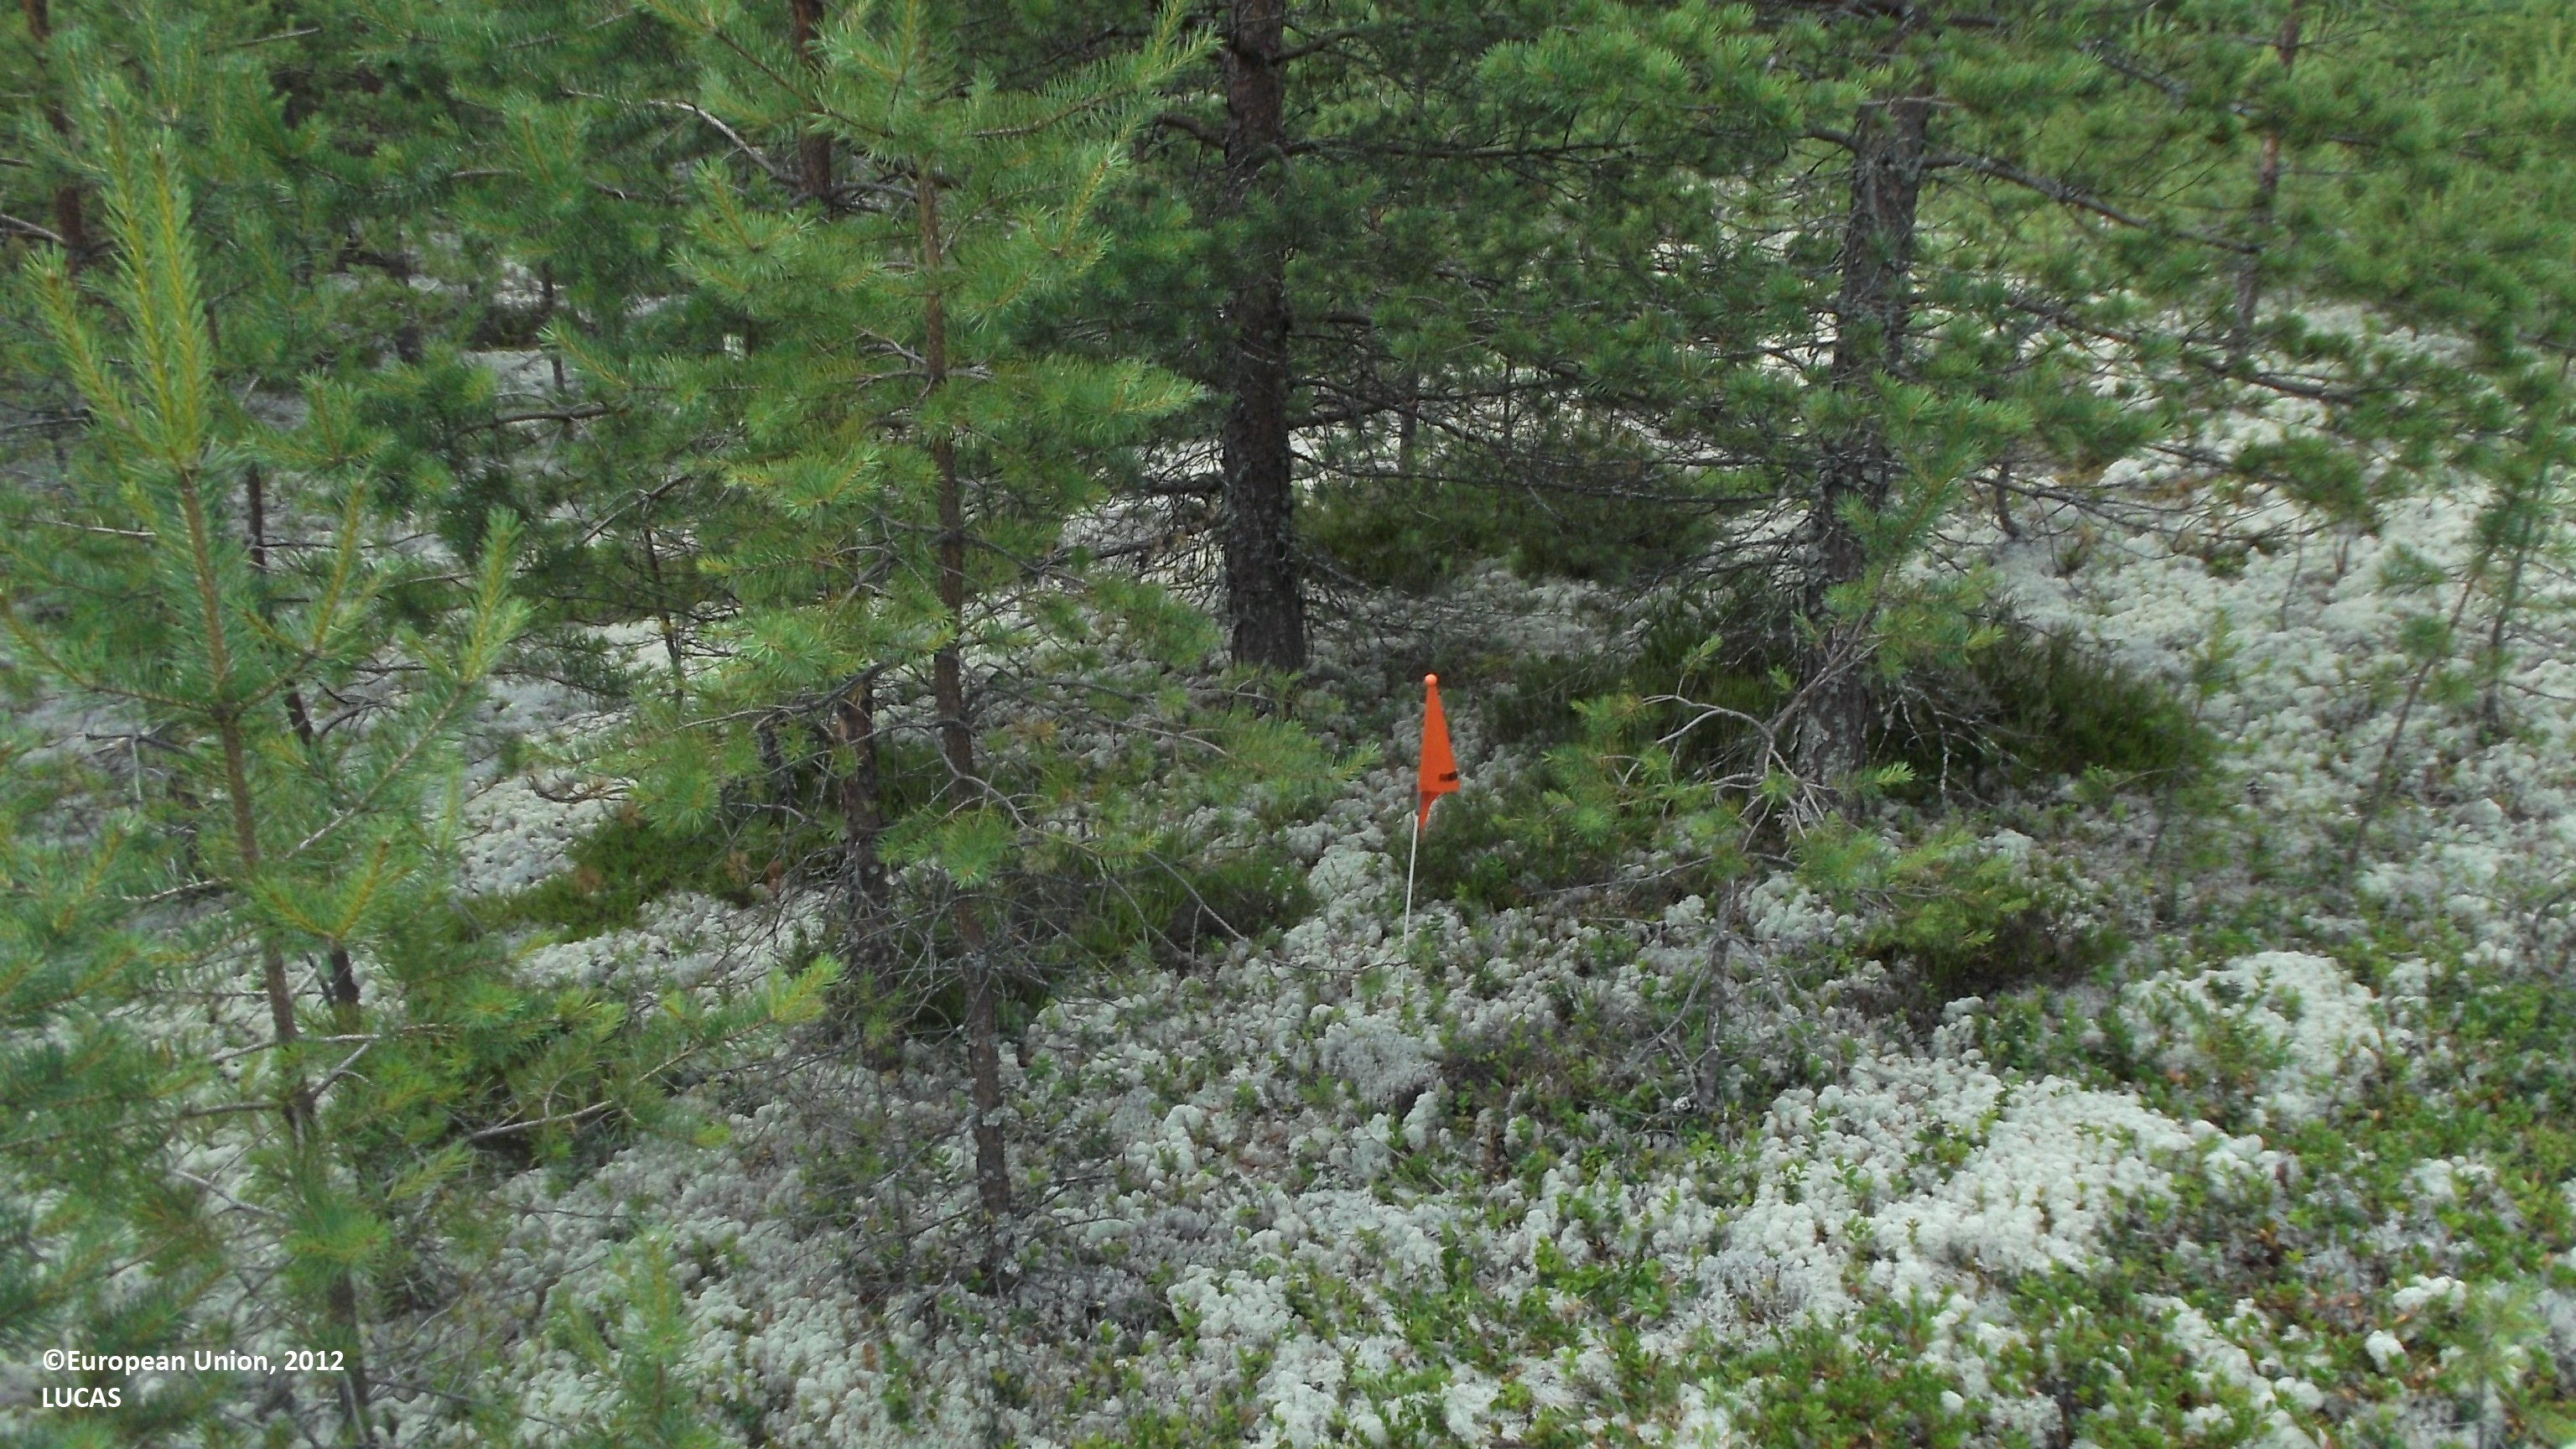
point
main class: Woodland
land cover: Pine dominated coniferous woodland
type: boreal forest
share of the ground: 25 - 50 %
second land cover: Lichens and moss
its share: 50 - 75 %
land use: Forestry
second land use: Semi-natural and natural areas not in use
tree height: > 5 m
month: July
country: FI
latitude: 63.9815
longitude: 23.5224
